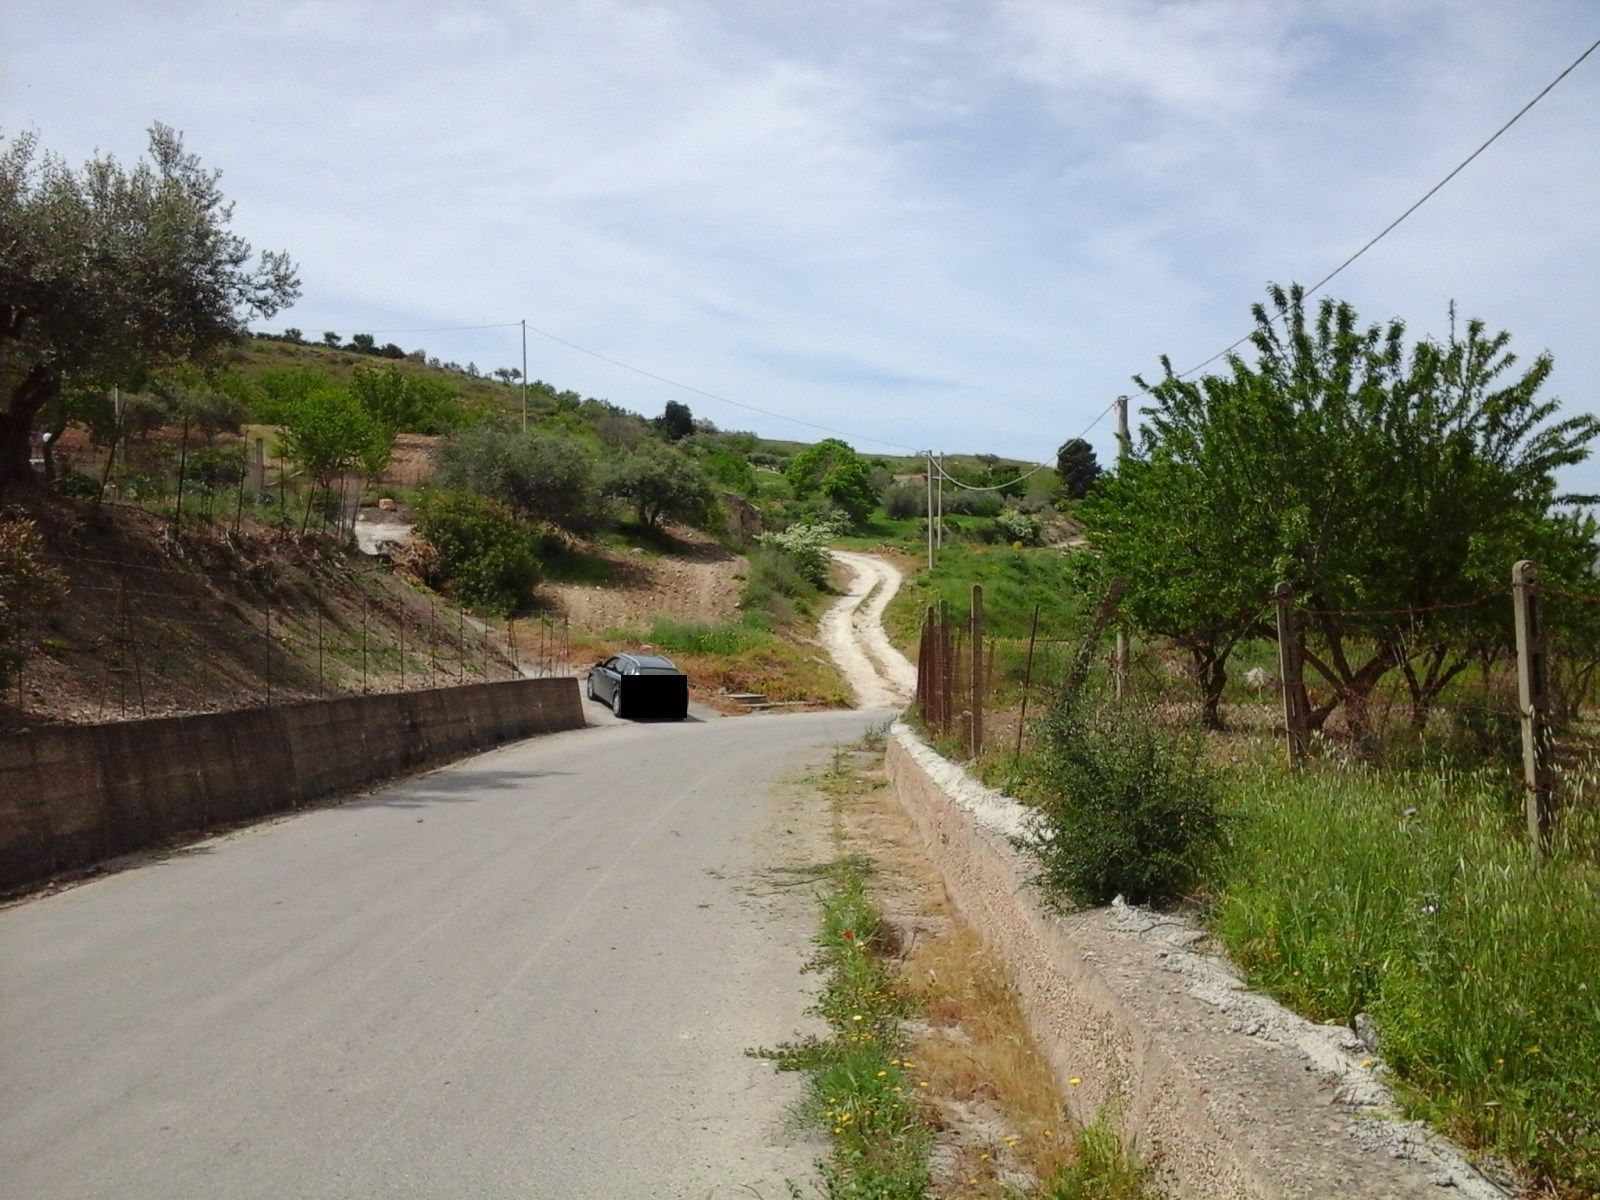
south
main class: Cropland
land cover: Nuts trees
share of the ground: > 75 %
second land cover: Other bare soil
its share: > 75 %
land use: Agriculture (excluding fallow land and kitchen gardens)
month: May
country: IT
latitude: 37.4040
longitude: 14.1149
